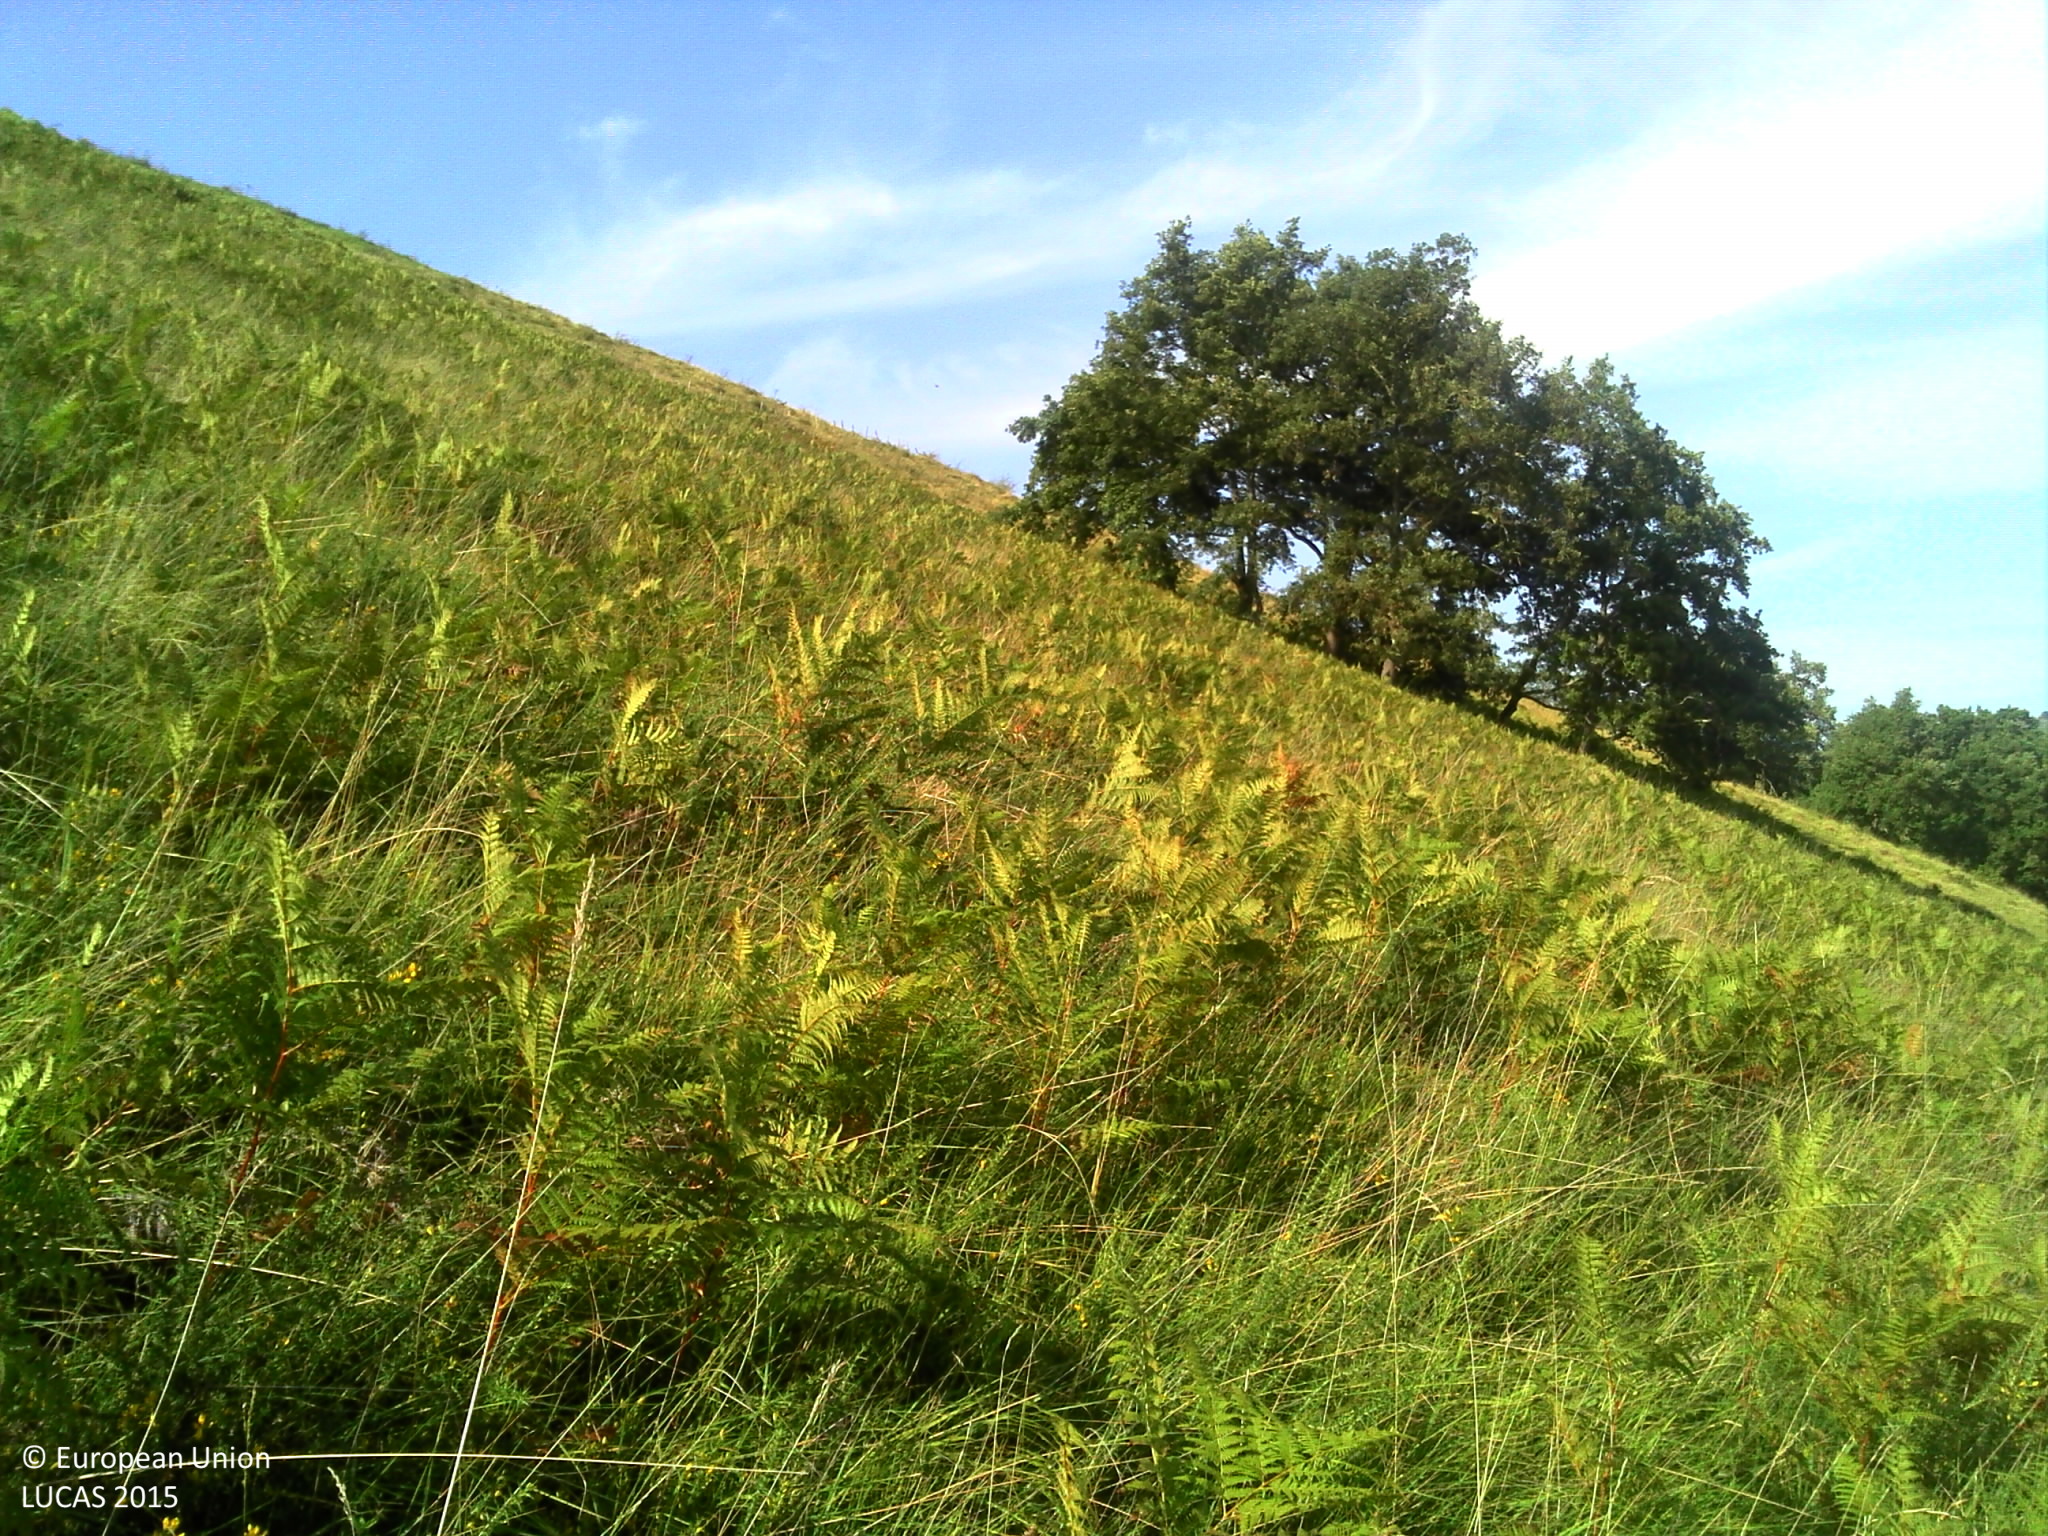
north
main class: Grassland
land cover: Grassland without tree/shrub cover
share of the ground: > 75 %
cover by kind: herbaceous plants 90 %, shrubs 5 %, consolidated bare surface 5 %
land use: Agriculture (excluding fallow land and kitchen gardens)
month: September
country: FR
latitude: 43.1919
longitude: -1.0743
